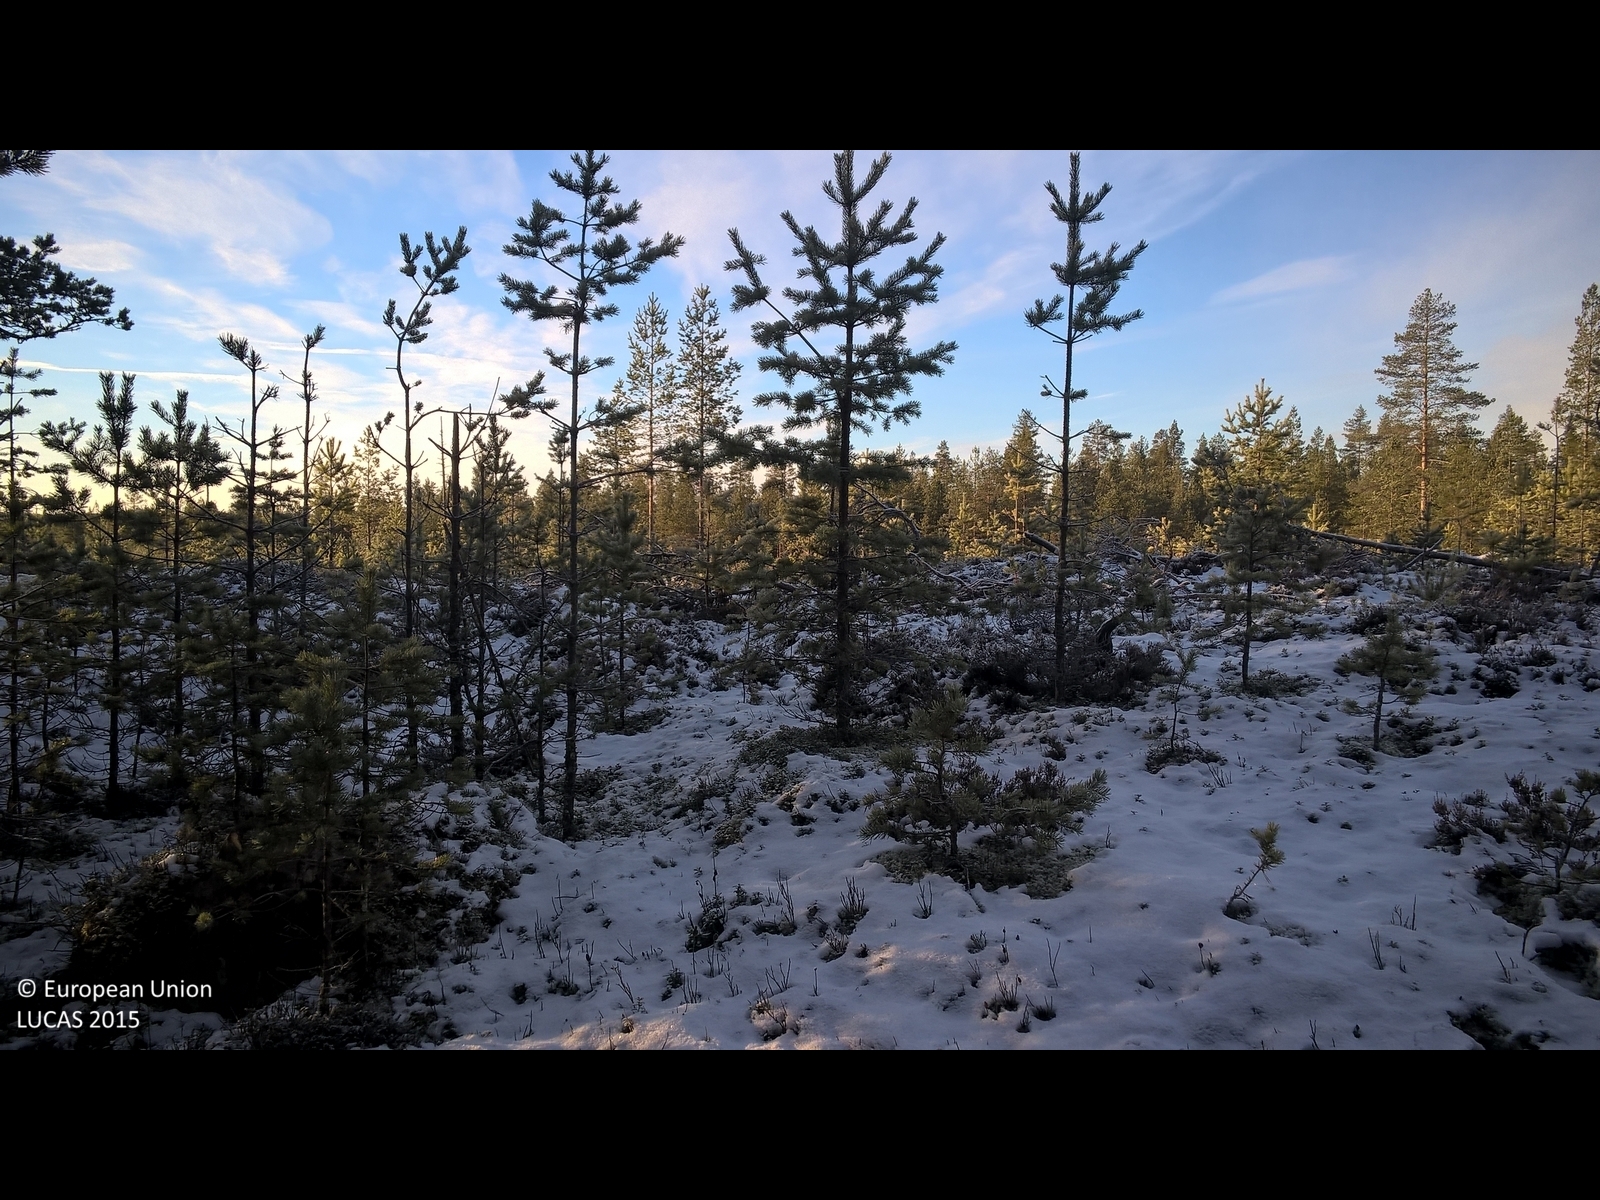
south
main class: Woodland
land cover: Pine dominated coniferous woodland
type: boreal forest
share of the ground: > 75 %
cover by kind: coniferous forest trees 75 %, lichens and mosses 25 %
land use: Forestry
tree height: > 5 m
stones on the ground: < 10 %
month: November
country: SE
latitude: 60.7295
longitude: 13.6010
